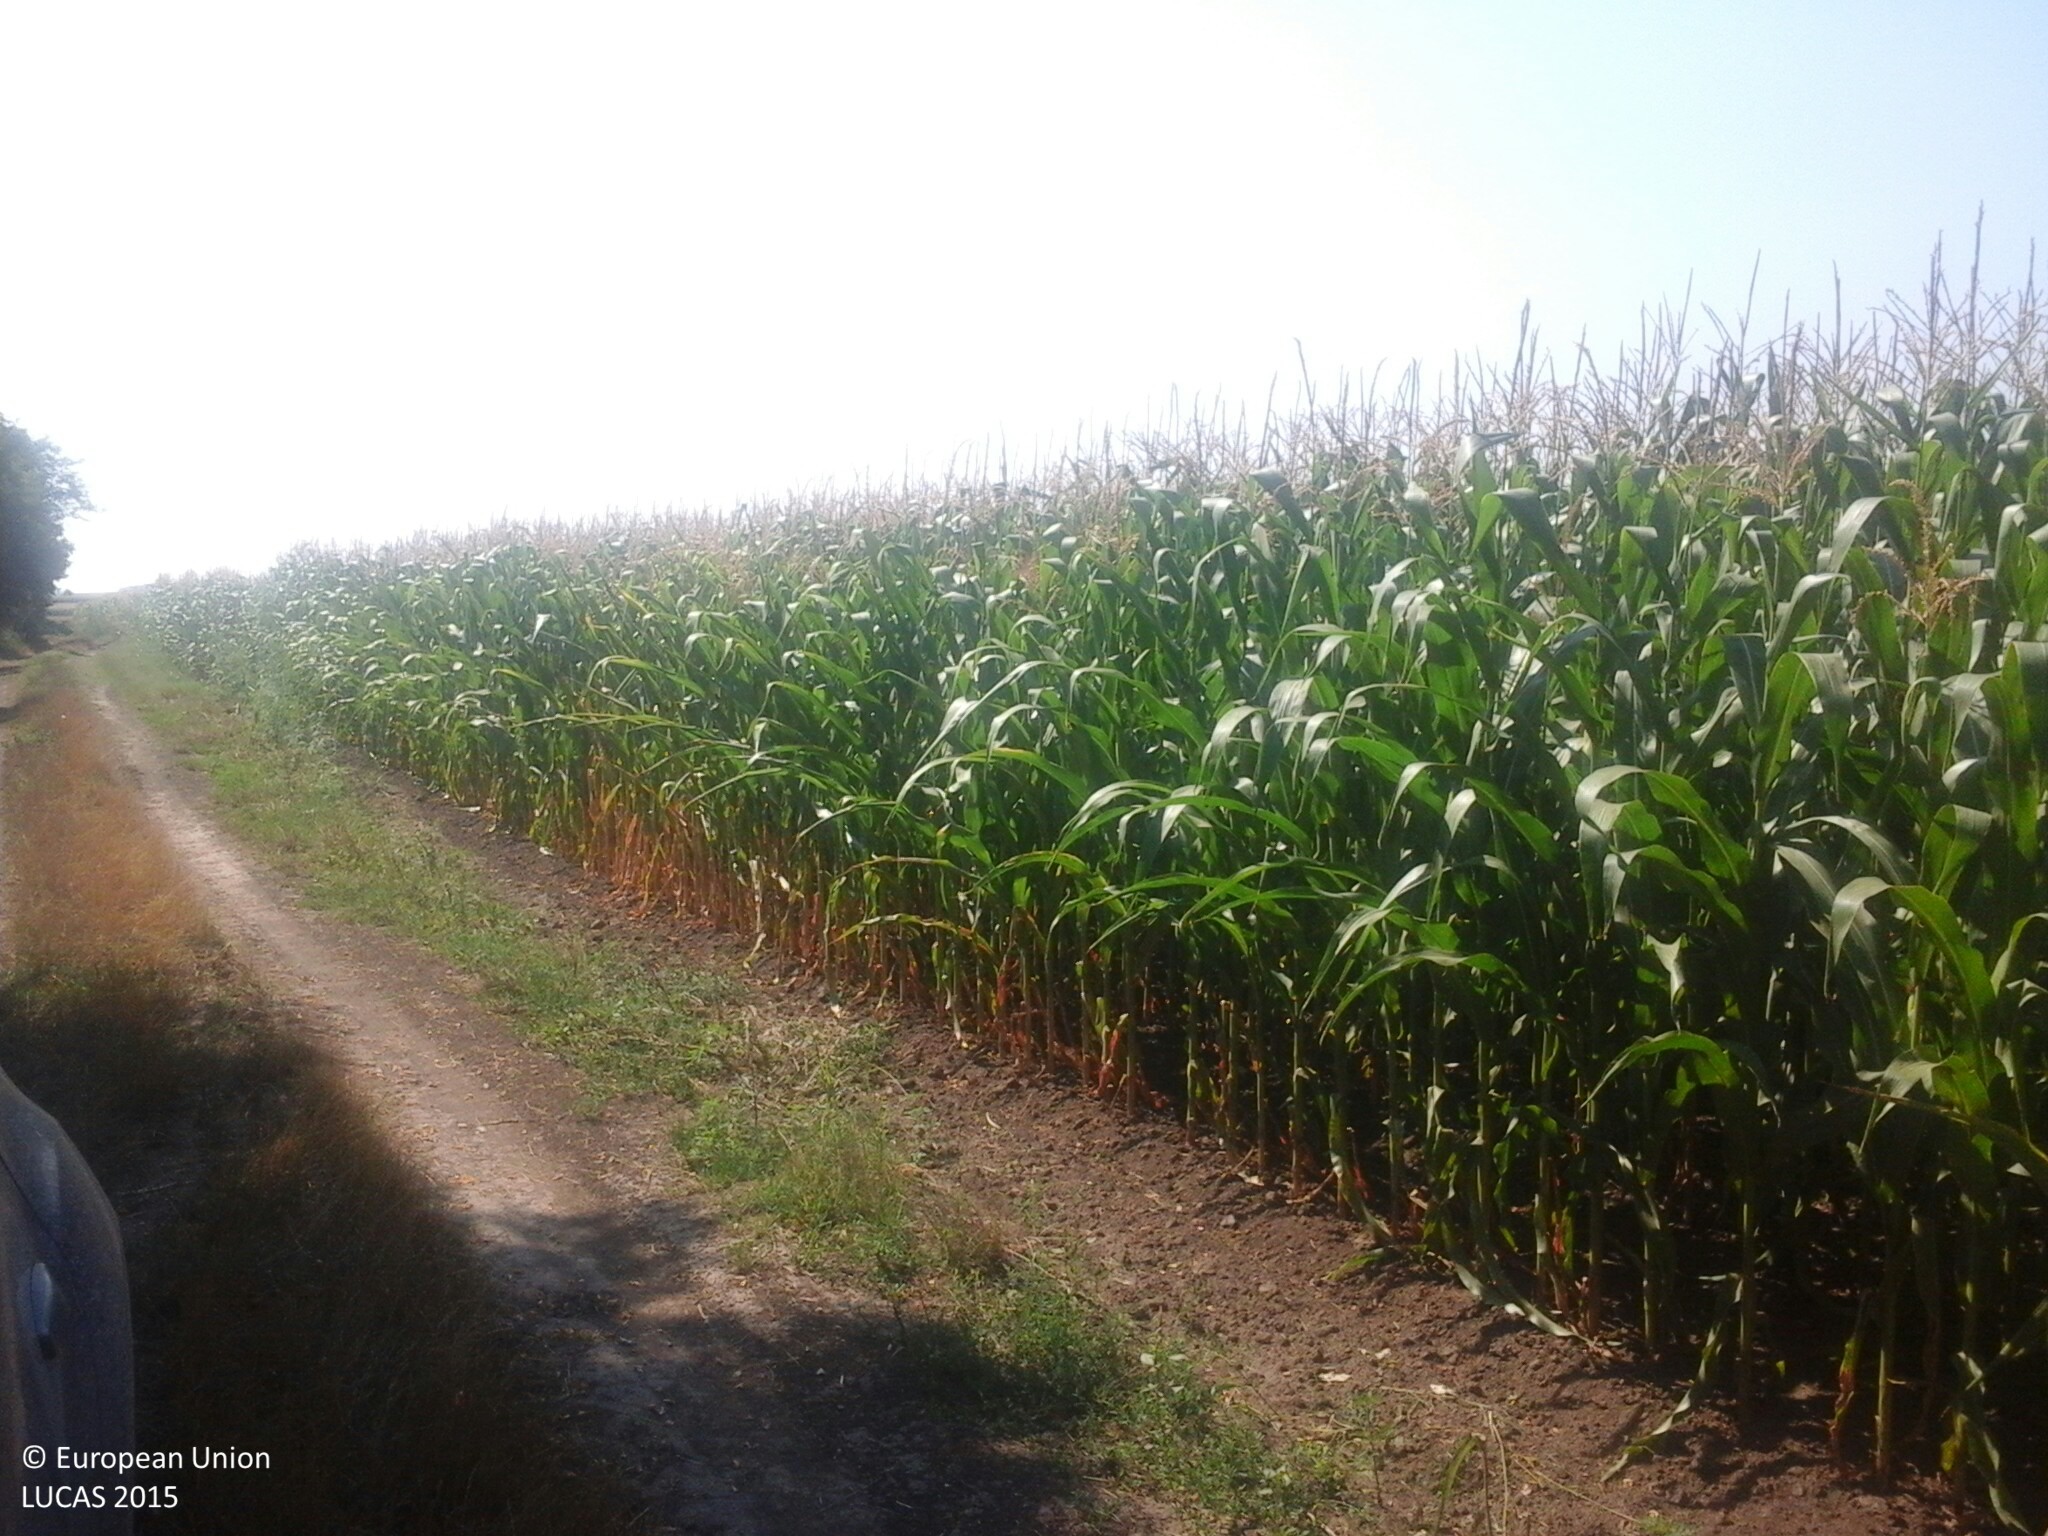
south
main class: Cropland
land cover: Sunflower
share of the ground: > 75 %
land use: Agriculture (excluding fallow land and kitchen gardens)
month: August
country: HU
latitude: 46.9390
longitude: 18.4582
